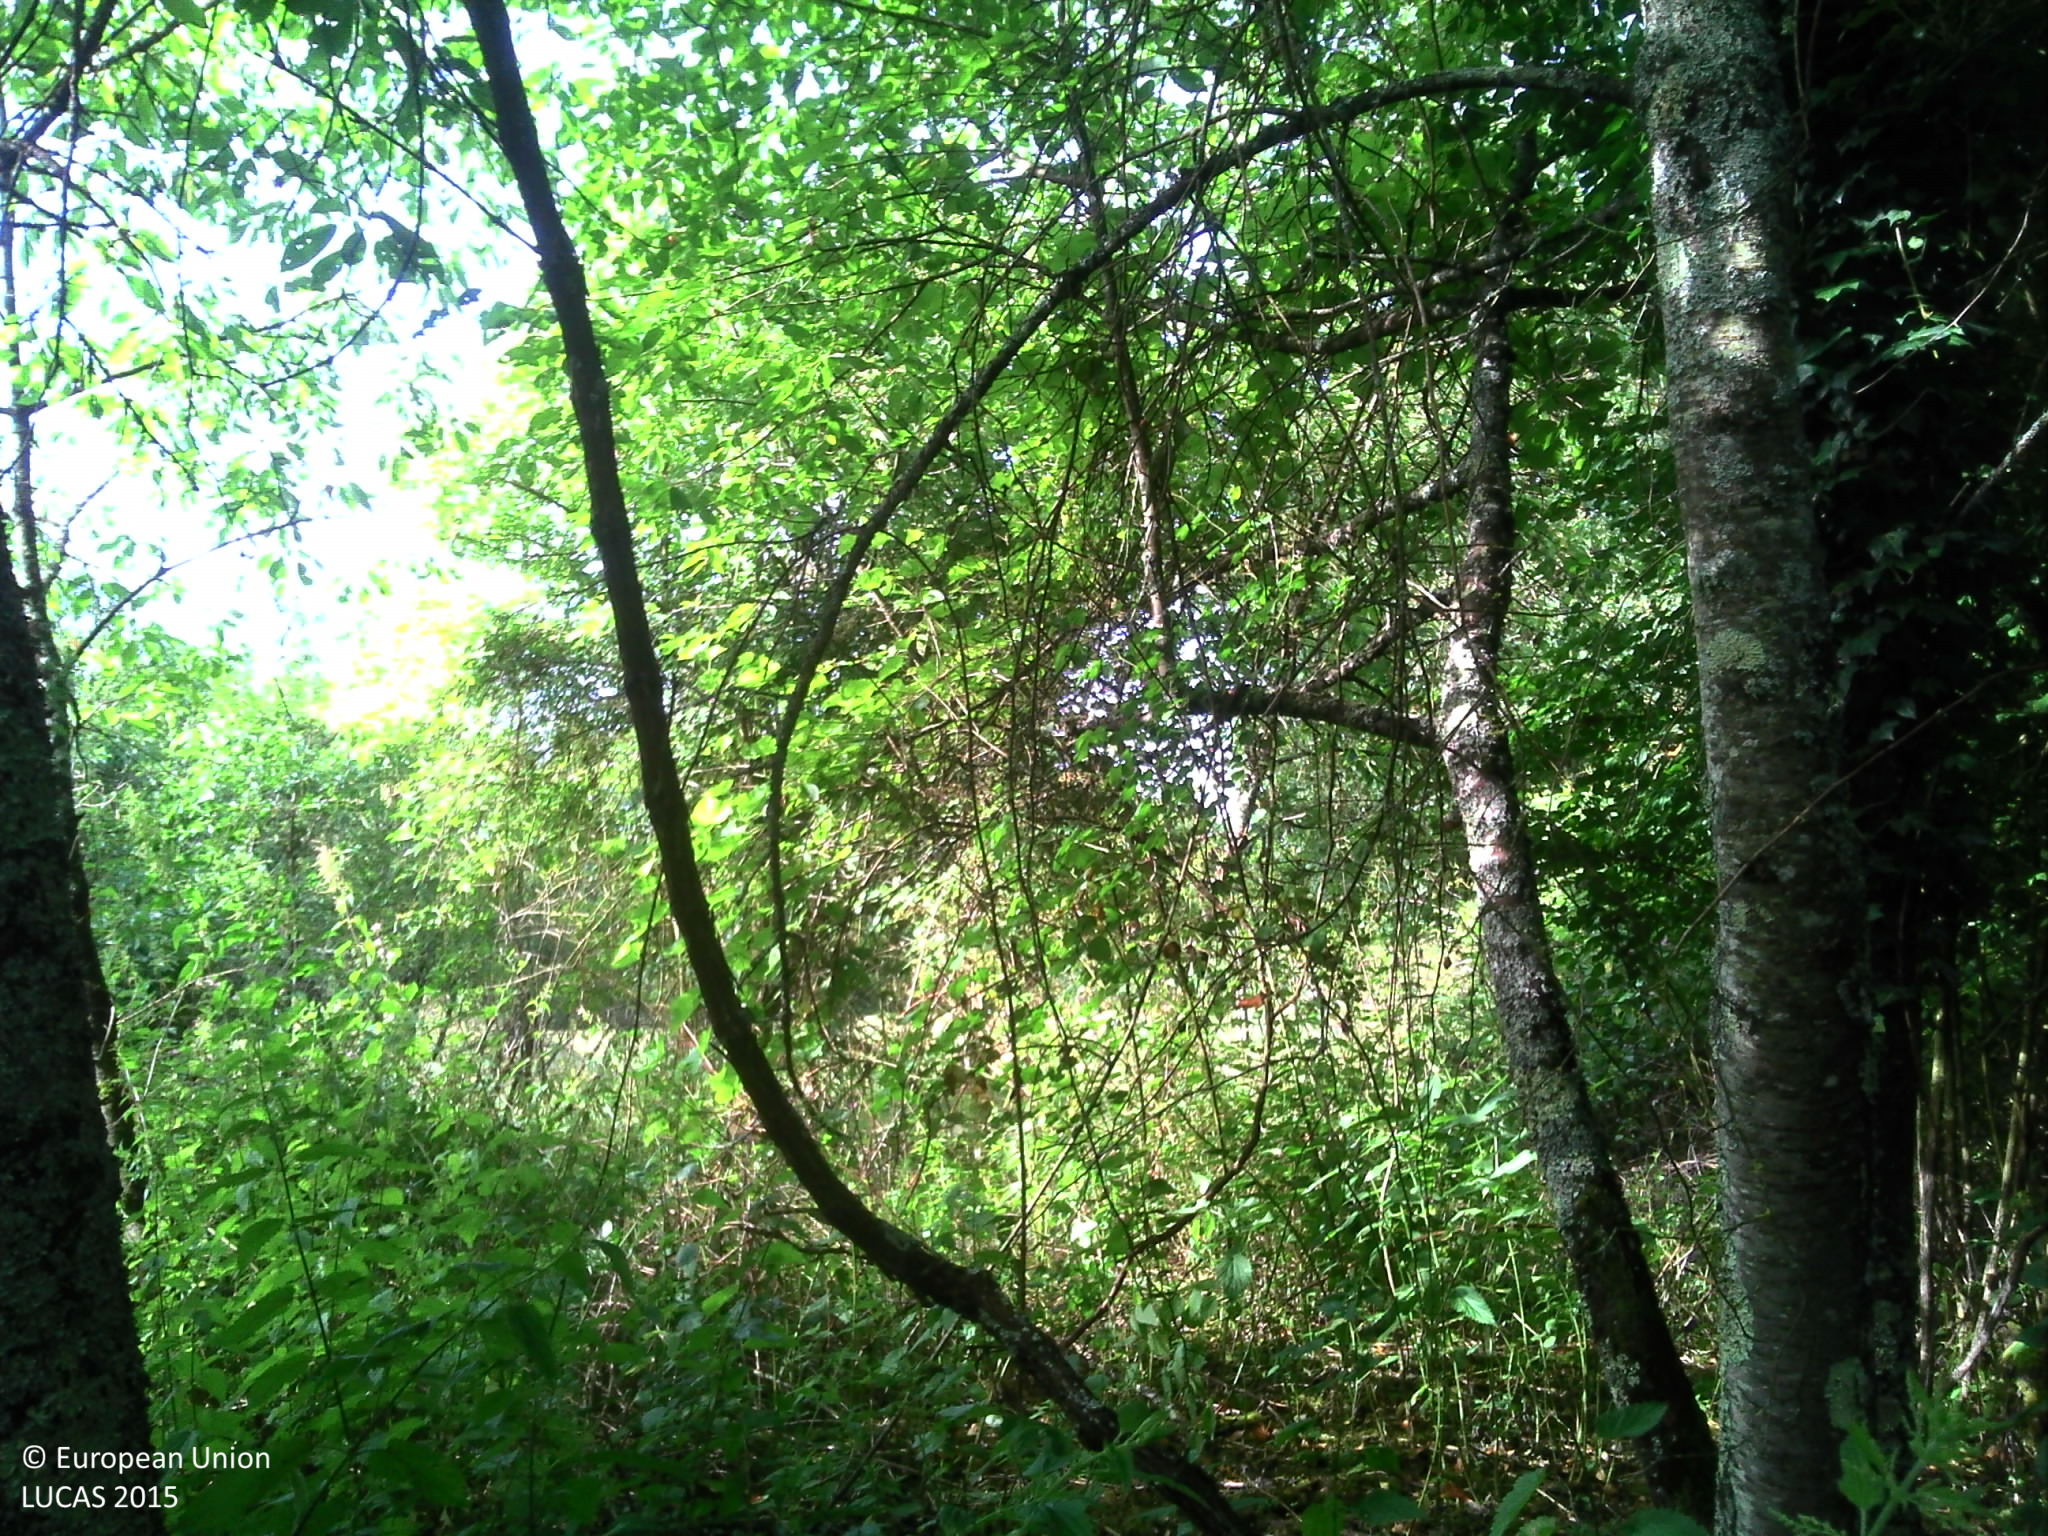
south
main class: Woodland
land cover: Other mixed woodland
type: mesophytic deciduous forest
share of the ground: > 75 %
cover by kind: broadleaved forest trees 50 %, coniferous forest trees 25 %, herbaceous plants 25 %
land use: Semi-natural and natural areas not in use
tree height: > 5 m
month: June
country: FR
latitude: 46.4715
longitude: 3.9965
